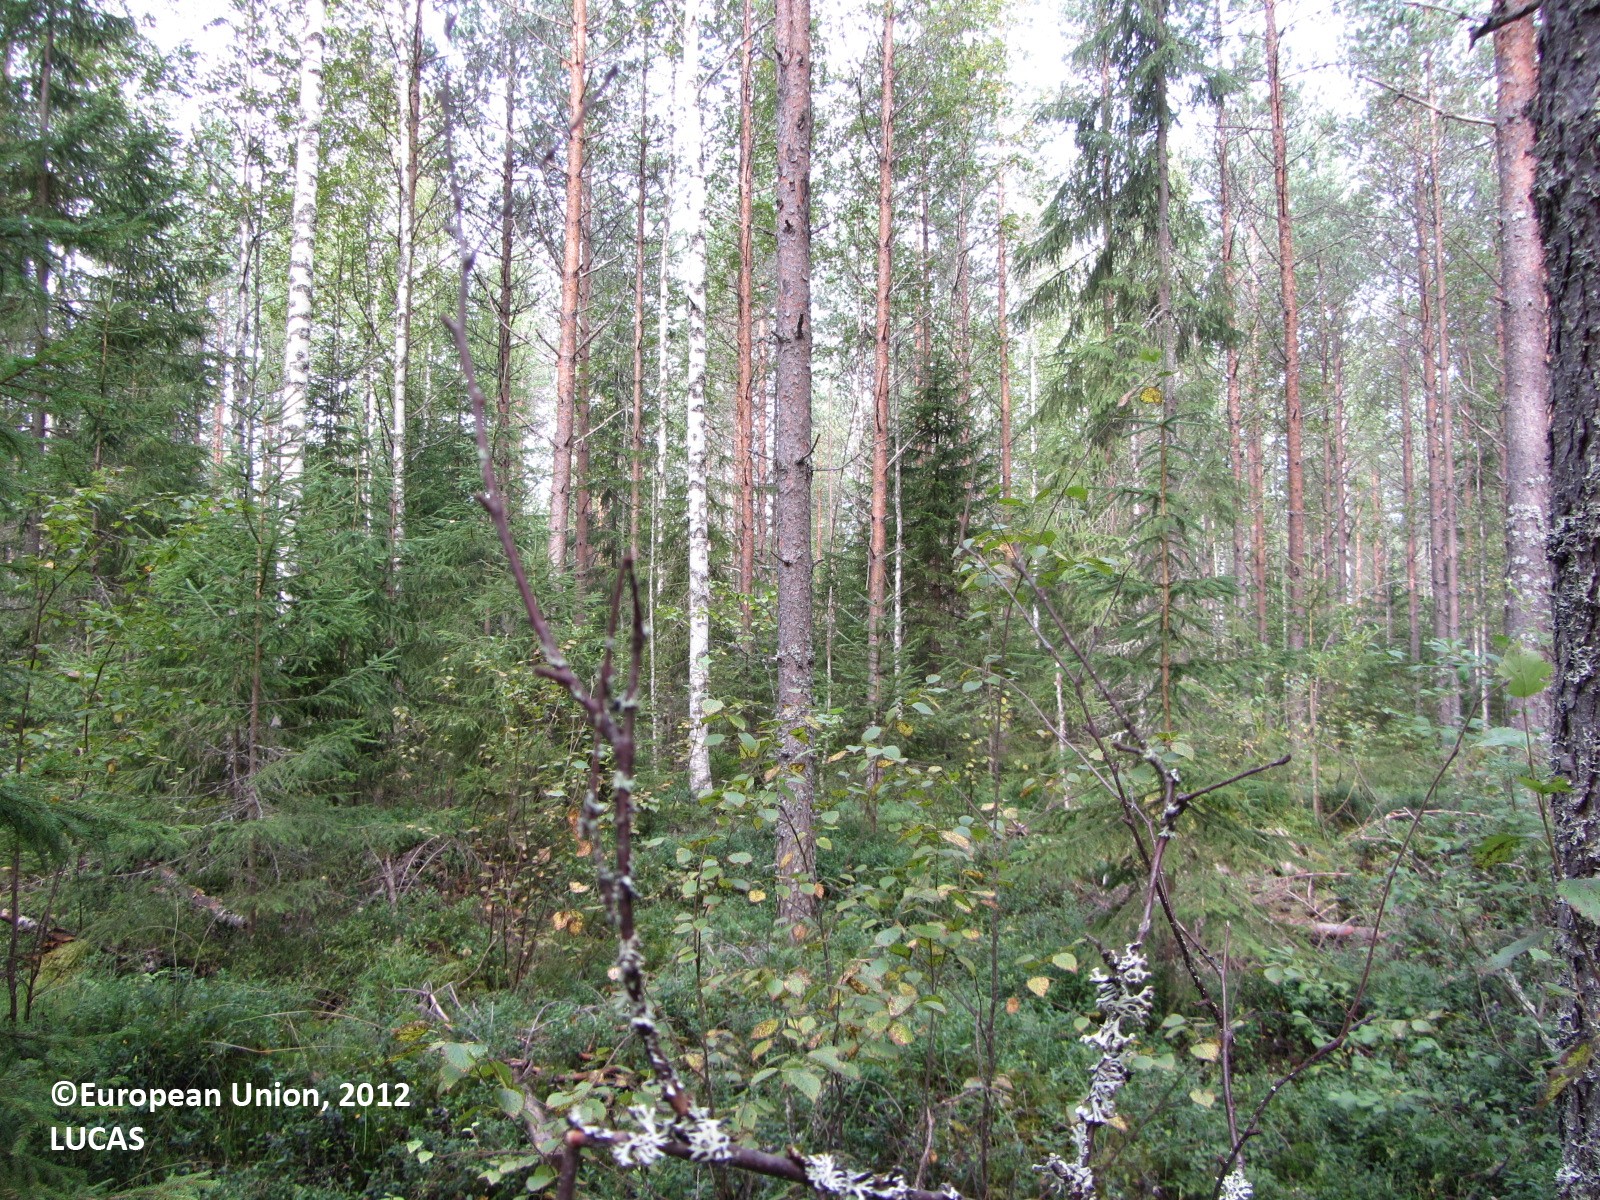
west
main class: Woodland
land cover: Pine dominated mixed woodland
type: boreal forest
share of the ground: > 75 %
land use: Forestry
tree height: > 5 m
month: August
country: FI
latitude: 63.0069
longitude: 25.0861
